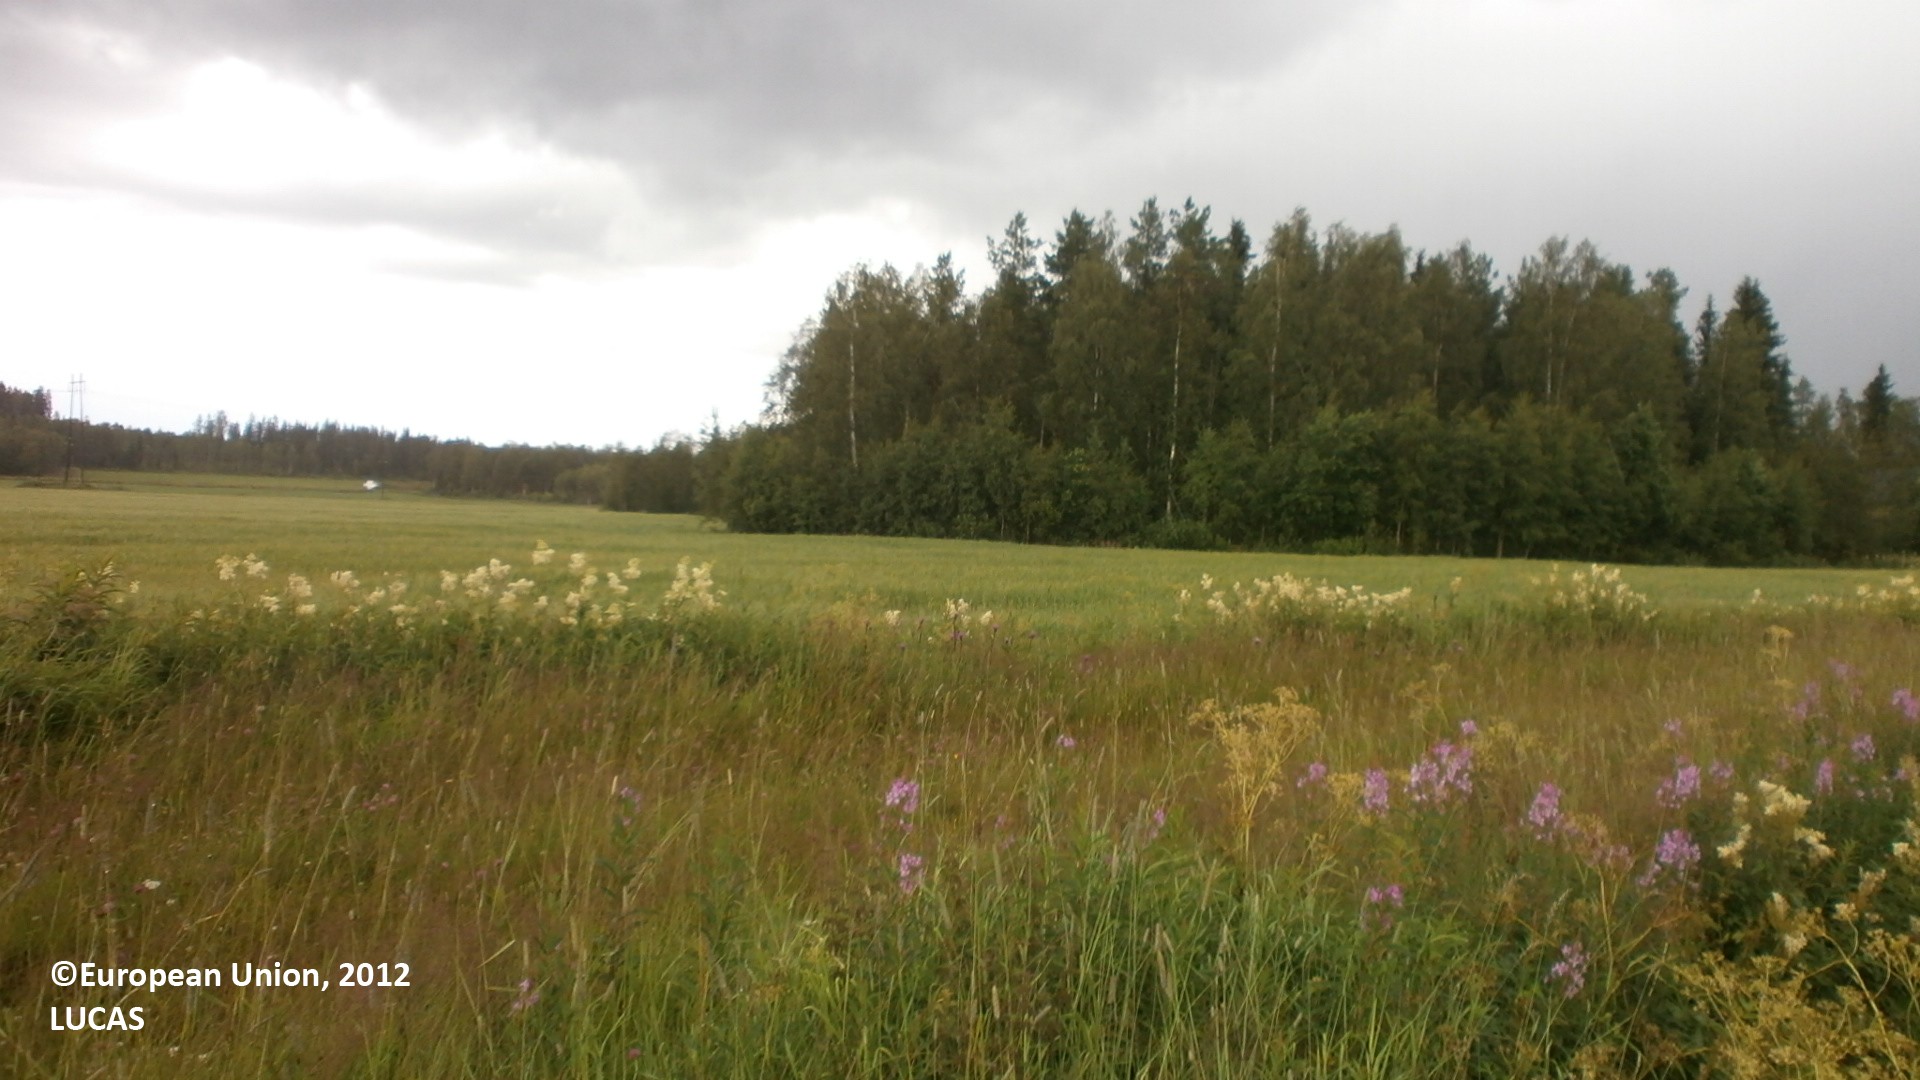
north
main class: Cropland
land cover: Barley
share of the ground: 50 - 75 %
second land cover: Oats
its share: 50 - 75 %
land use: Agriculture (excluding fallow land and kitchen gardens)
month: July
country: FI
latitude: 63.9174
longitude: 24.2387
